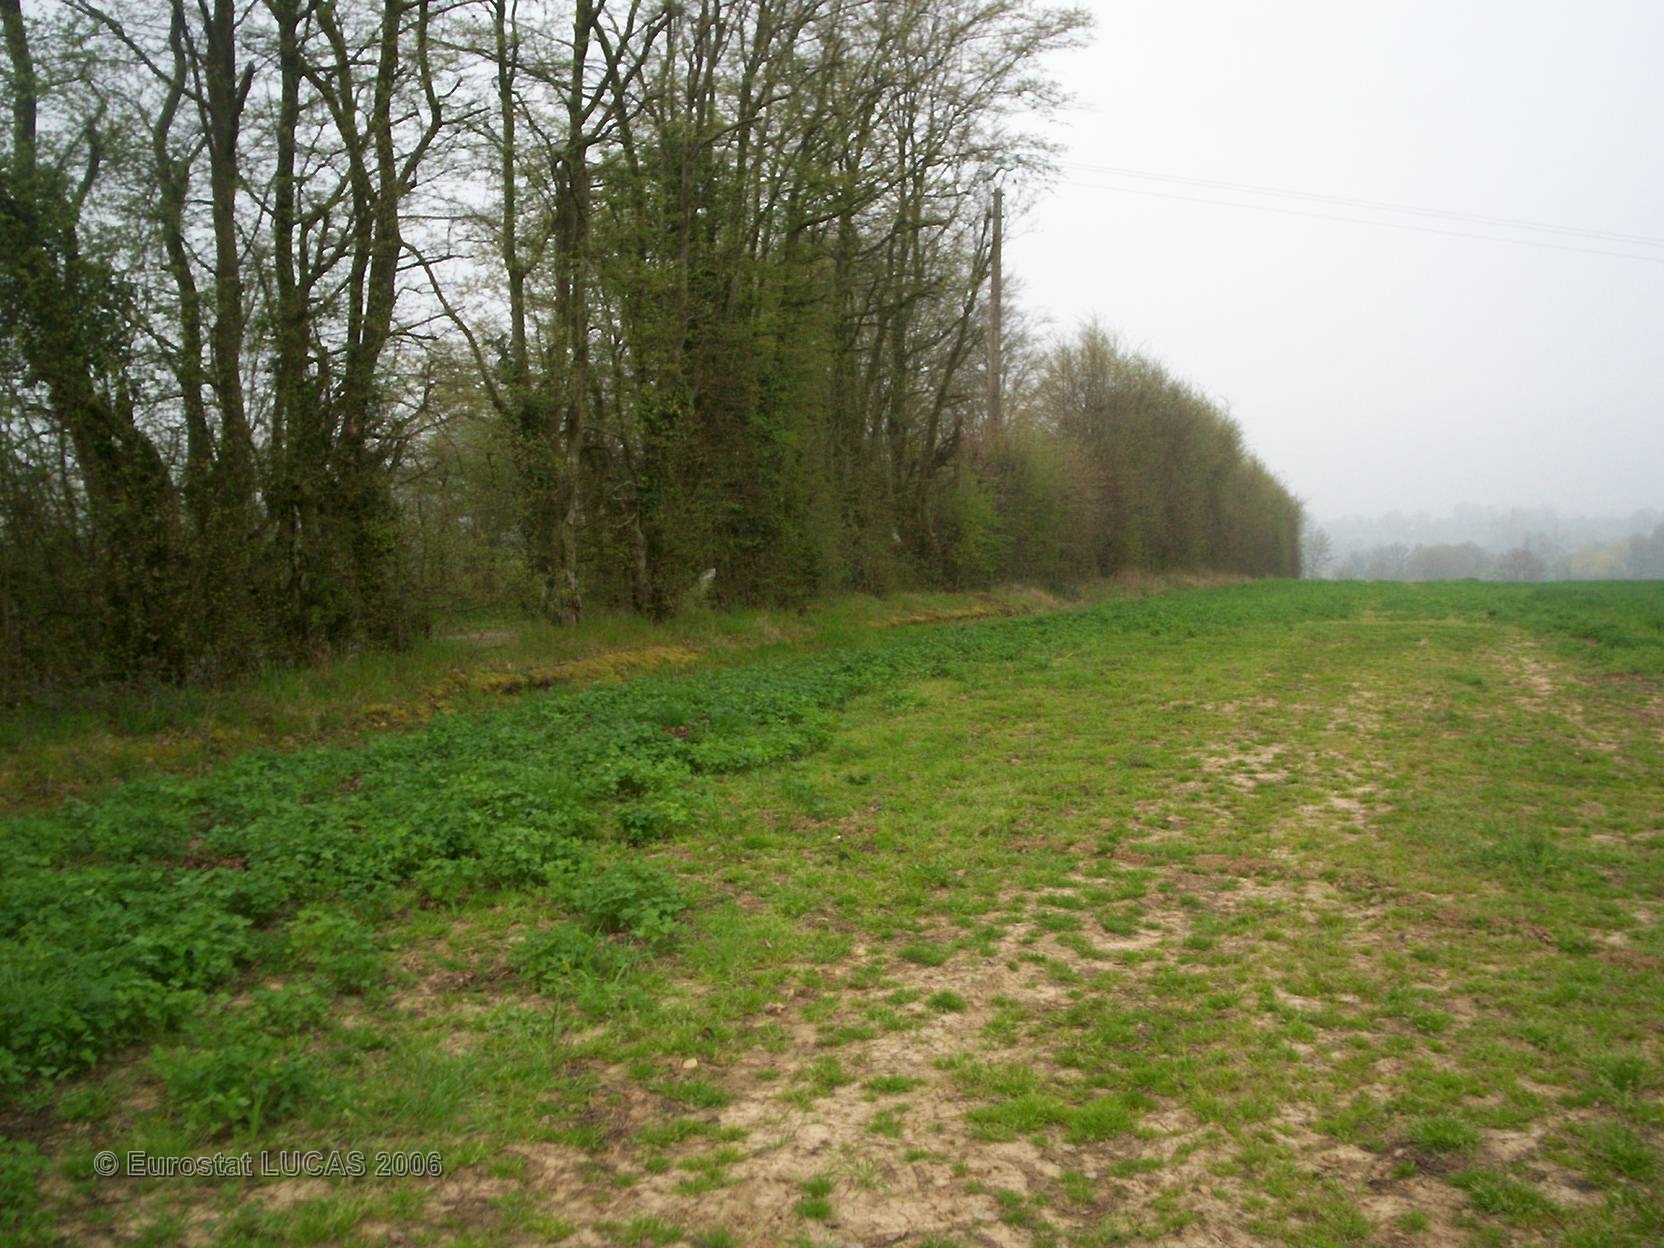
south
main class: Cropland
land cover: Clovers
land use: Agriculture (excluding fallow land and kitchen gardens)
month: May
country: FR
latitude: 48.6794
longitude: 0.2616
